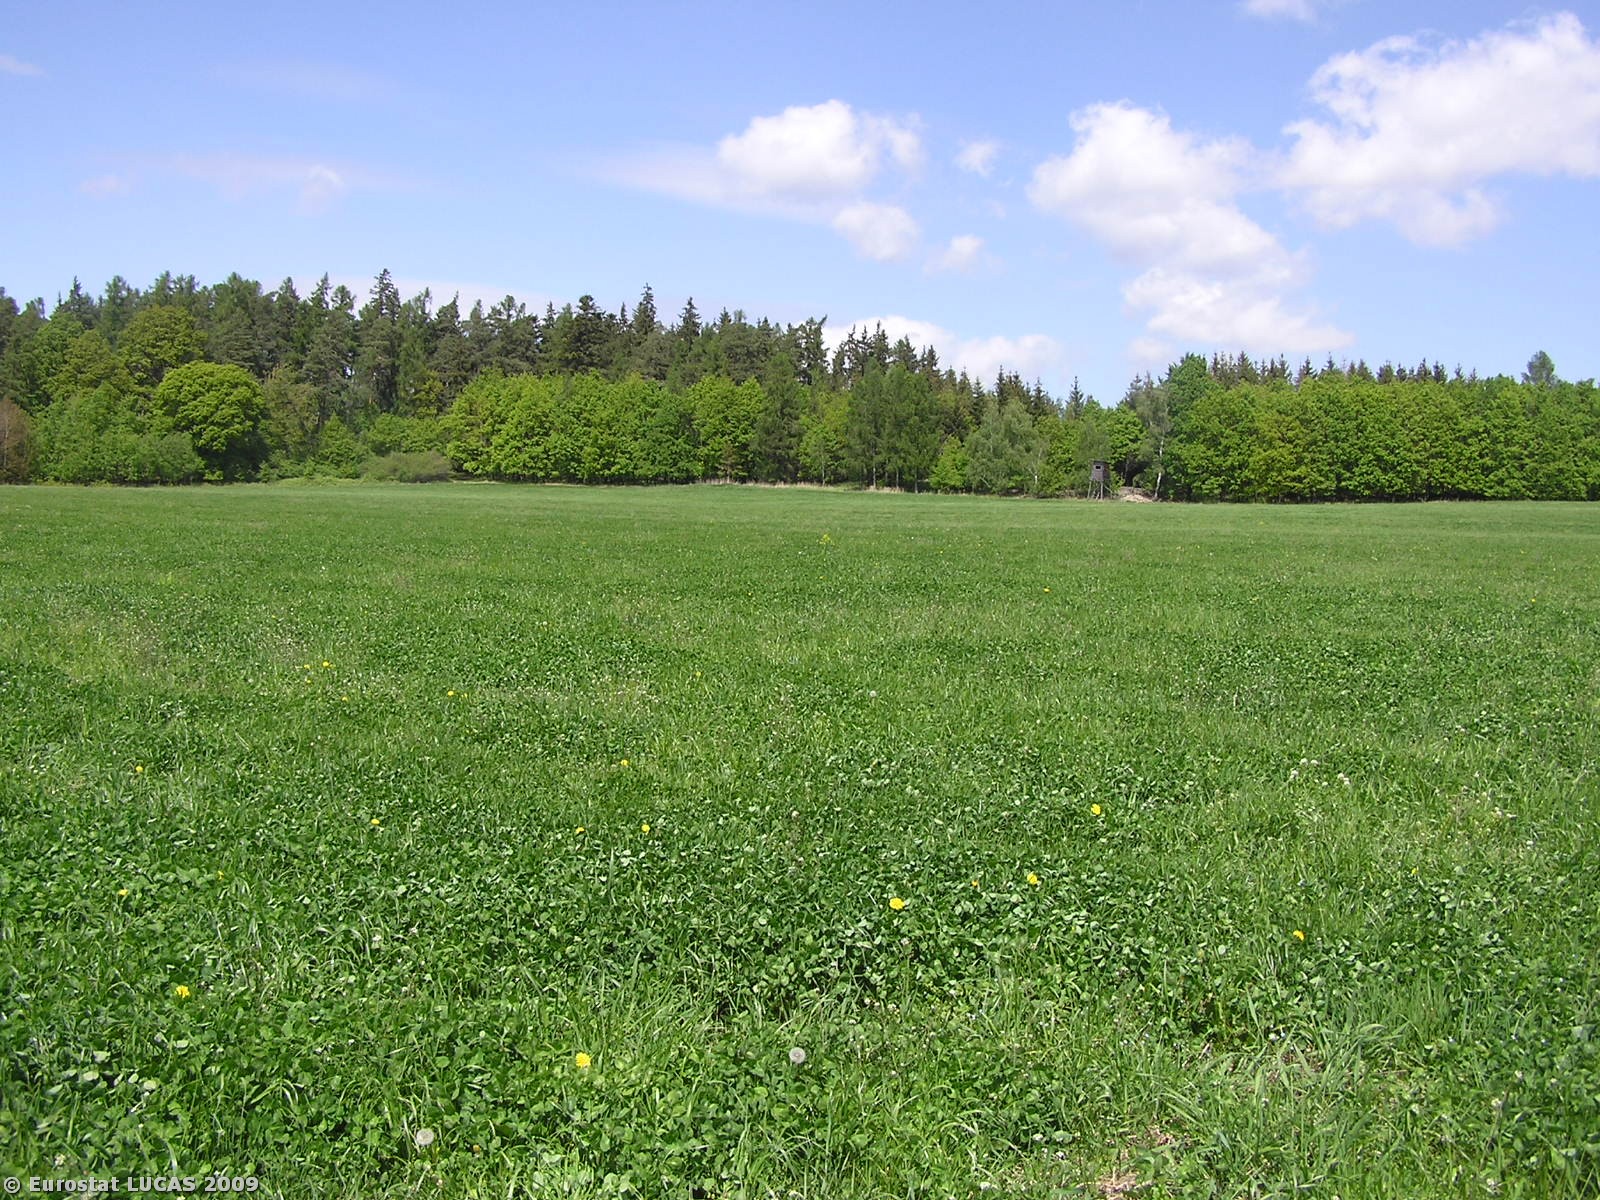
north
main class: Cropland
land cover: Clovers
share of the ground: > 75 %
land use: Agriculture (excluding fallow land and kitchen gardens)
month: May
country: CZ
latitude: 50.0194
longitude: 17.6195
